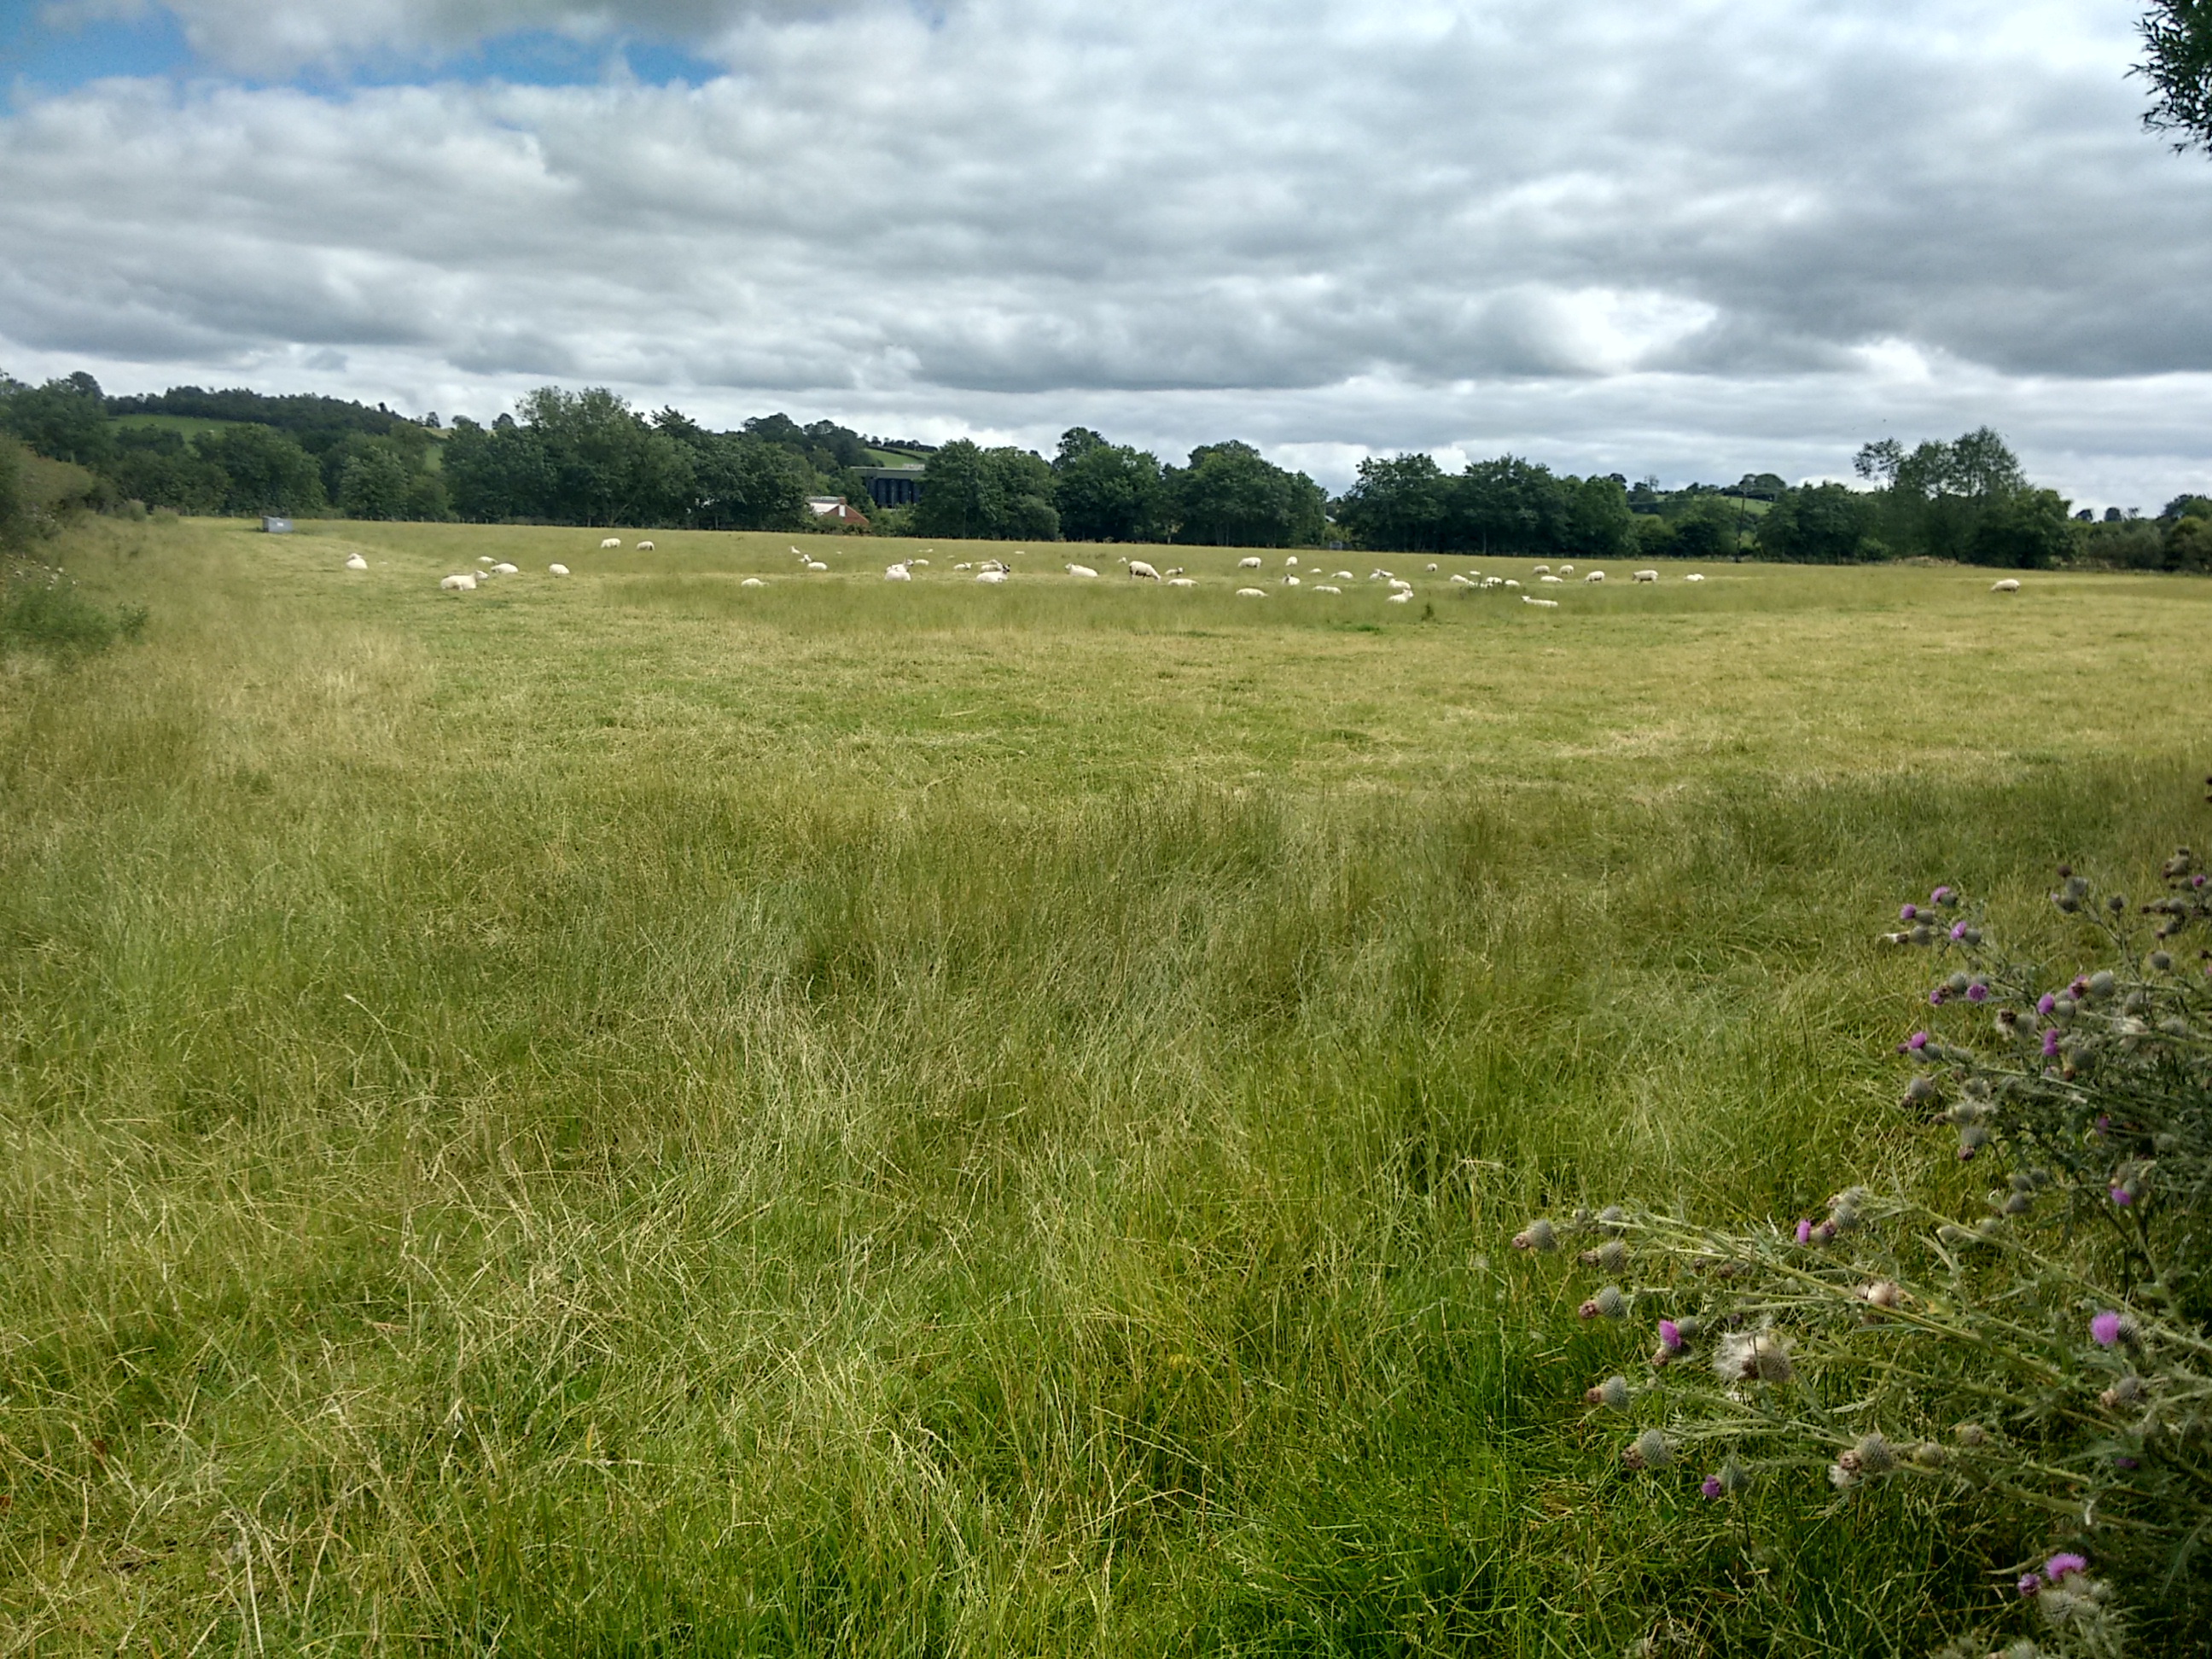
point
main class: Grassland
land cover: Grassland without tree/shrub cover
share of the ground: > 75 %
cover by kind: herbaceous plants 100 %
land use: Agriculture (excluding fallow land and kitchen gardens)
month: August
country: GB
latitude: 54.4416
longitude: -6.8019
